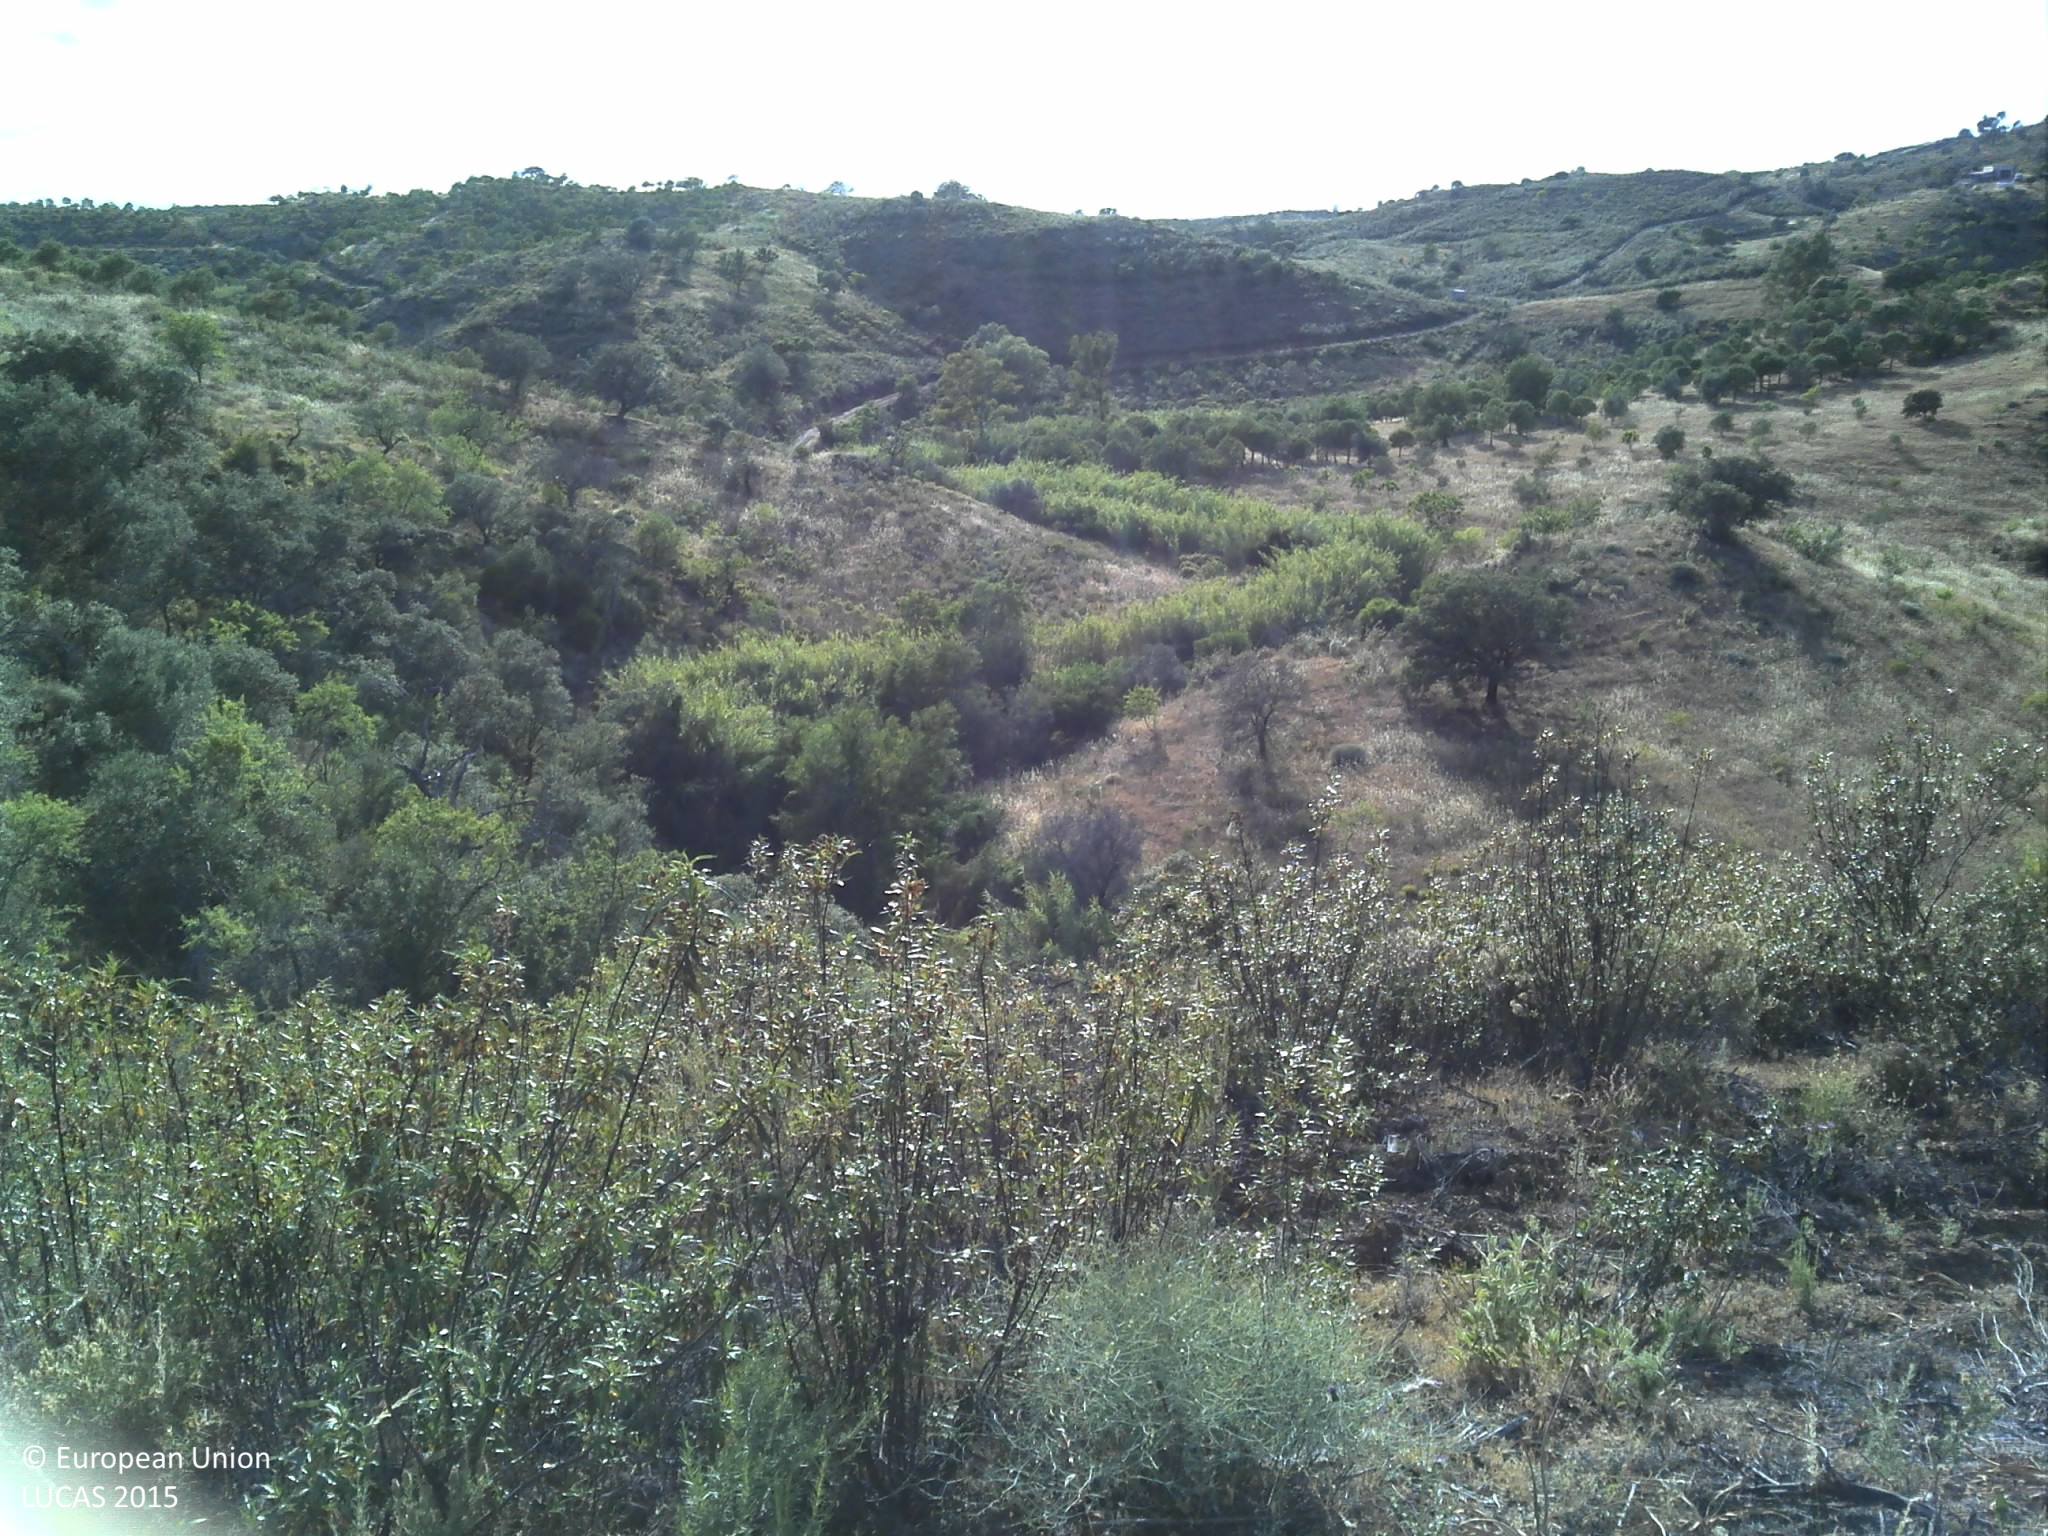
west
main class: Shrubland
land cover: Shrubland with sparse tree cover
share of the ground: 50 - 75 %
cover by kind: shrubs 75 %, unconsolidated bare surface 20 %, broadleaved forest trees 5 %
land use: Abandoned areas
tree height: > 5 m
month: May
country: PT
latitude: 37.2987
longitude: -7.4794
